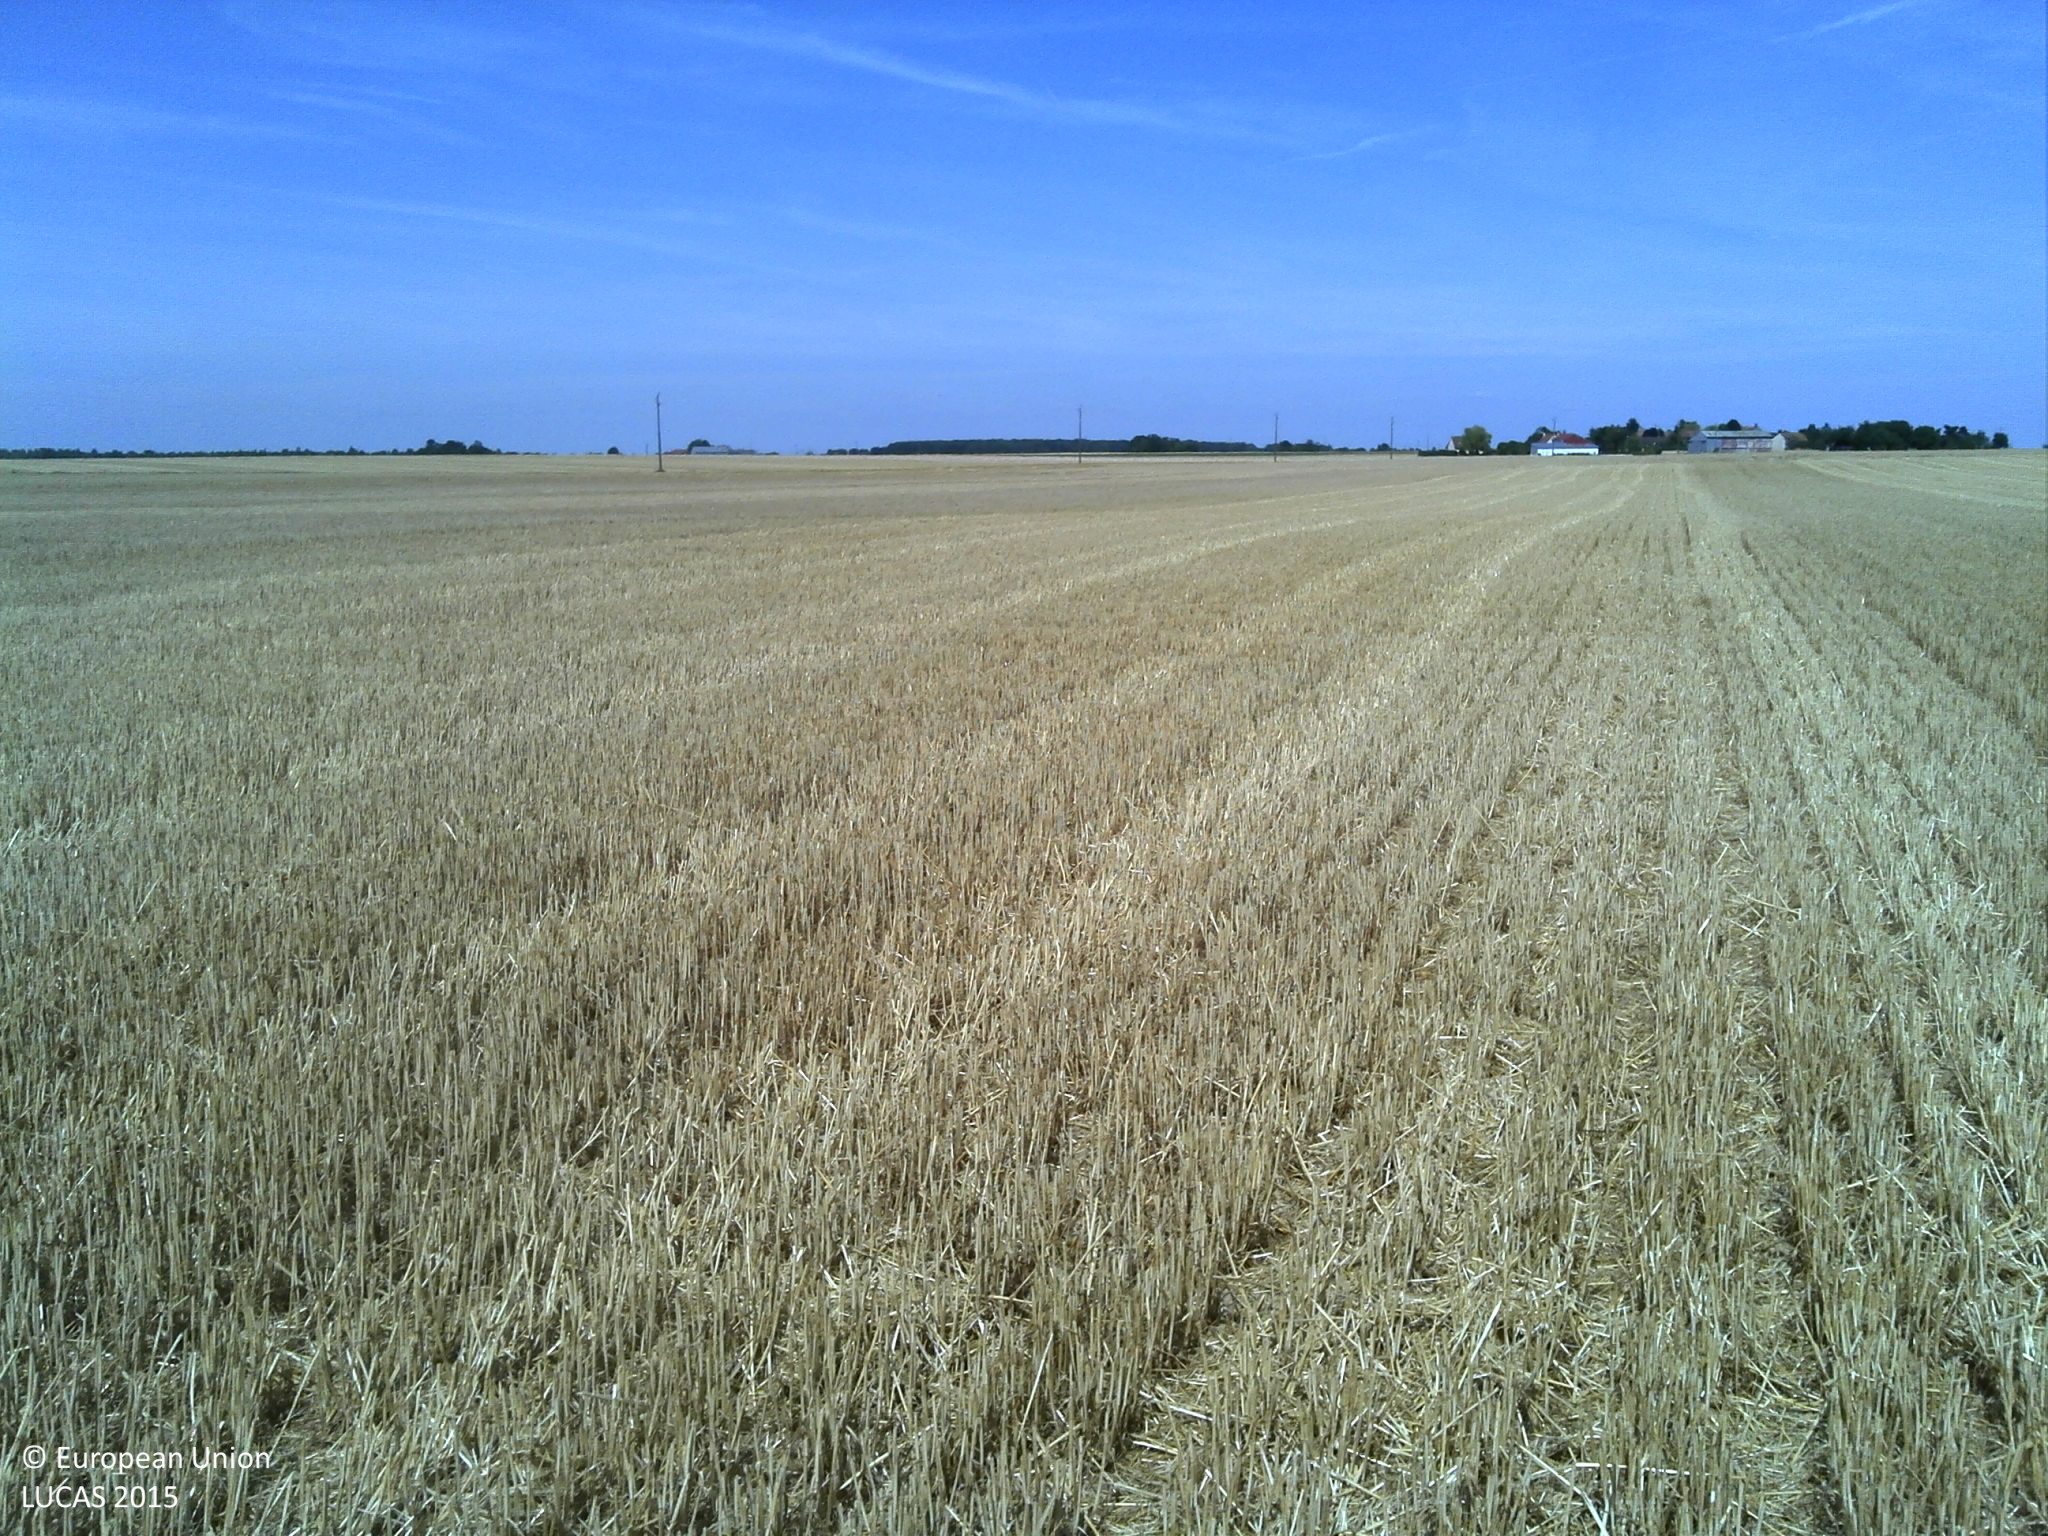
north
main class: Cropland
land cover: Common wheat
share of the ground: > 75 %
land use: Agriculture (excluding fallow land and kitchen gardens)
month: July
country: FR
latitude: 48.4665
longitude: 1.8845
